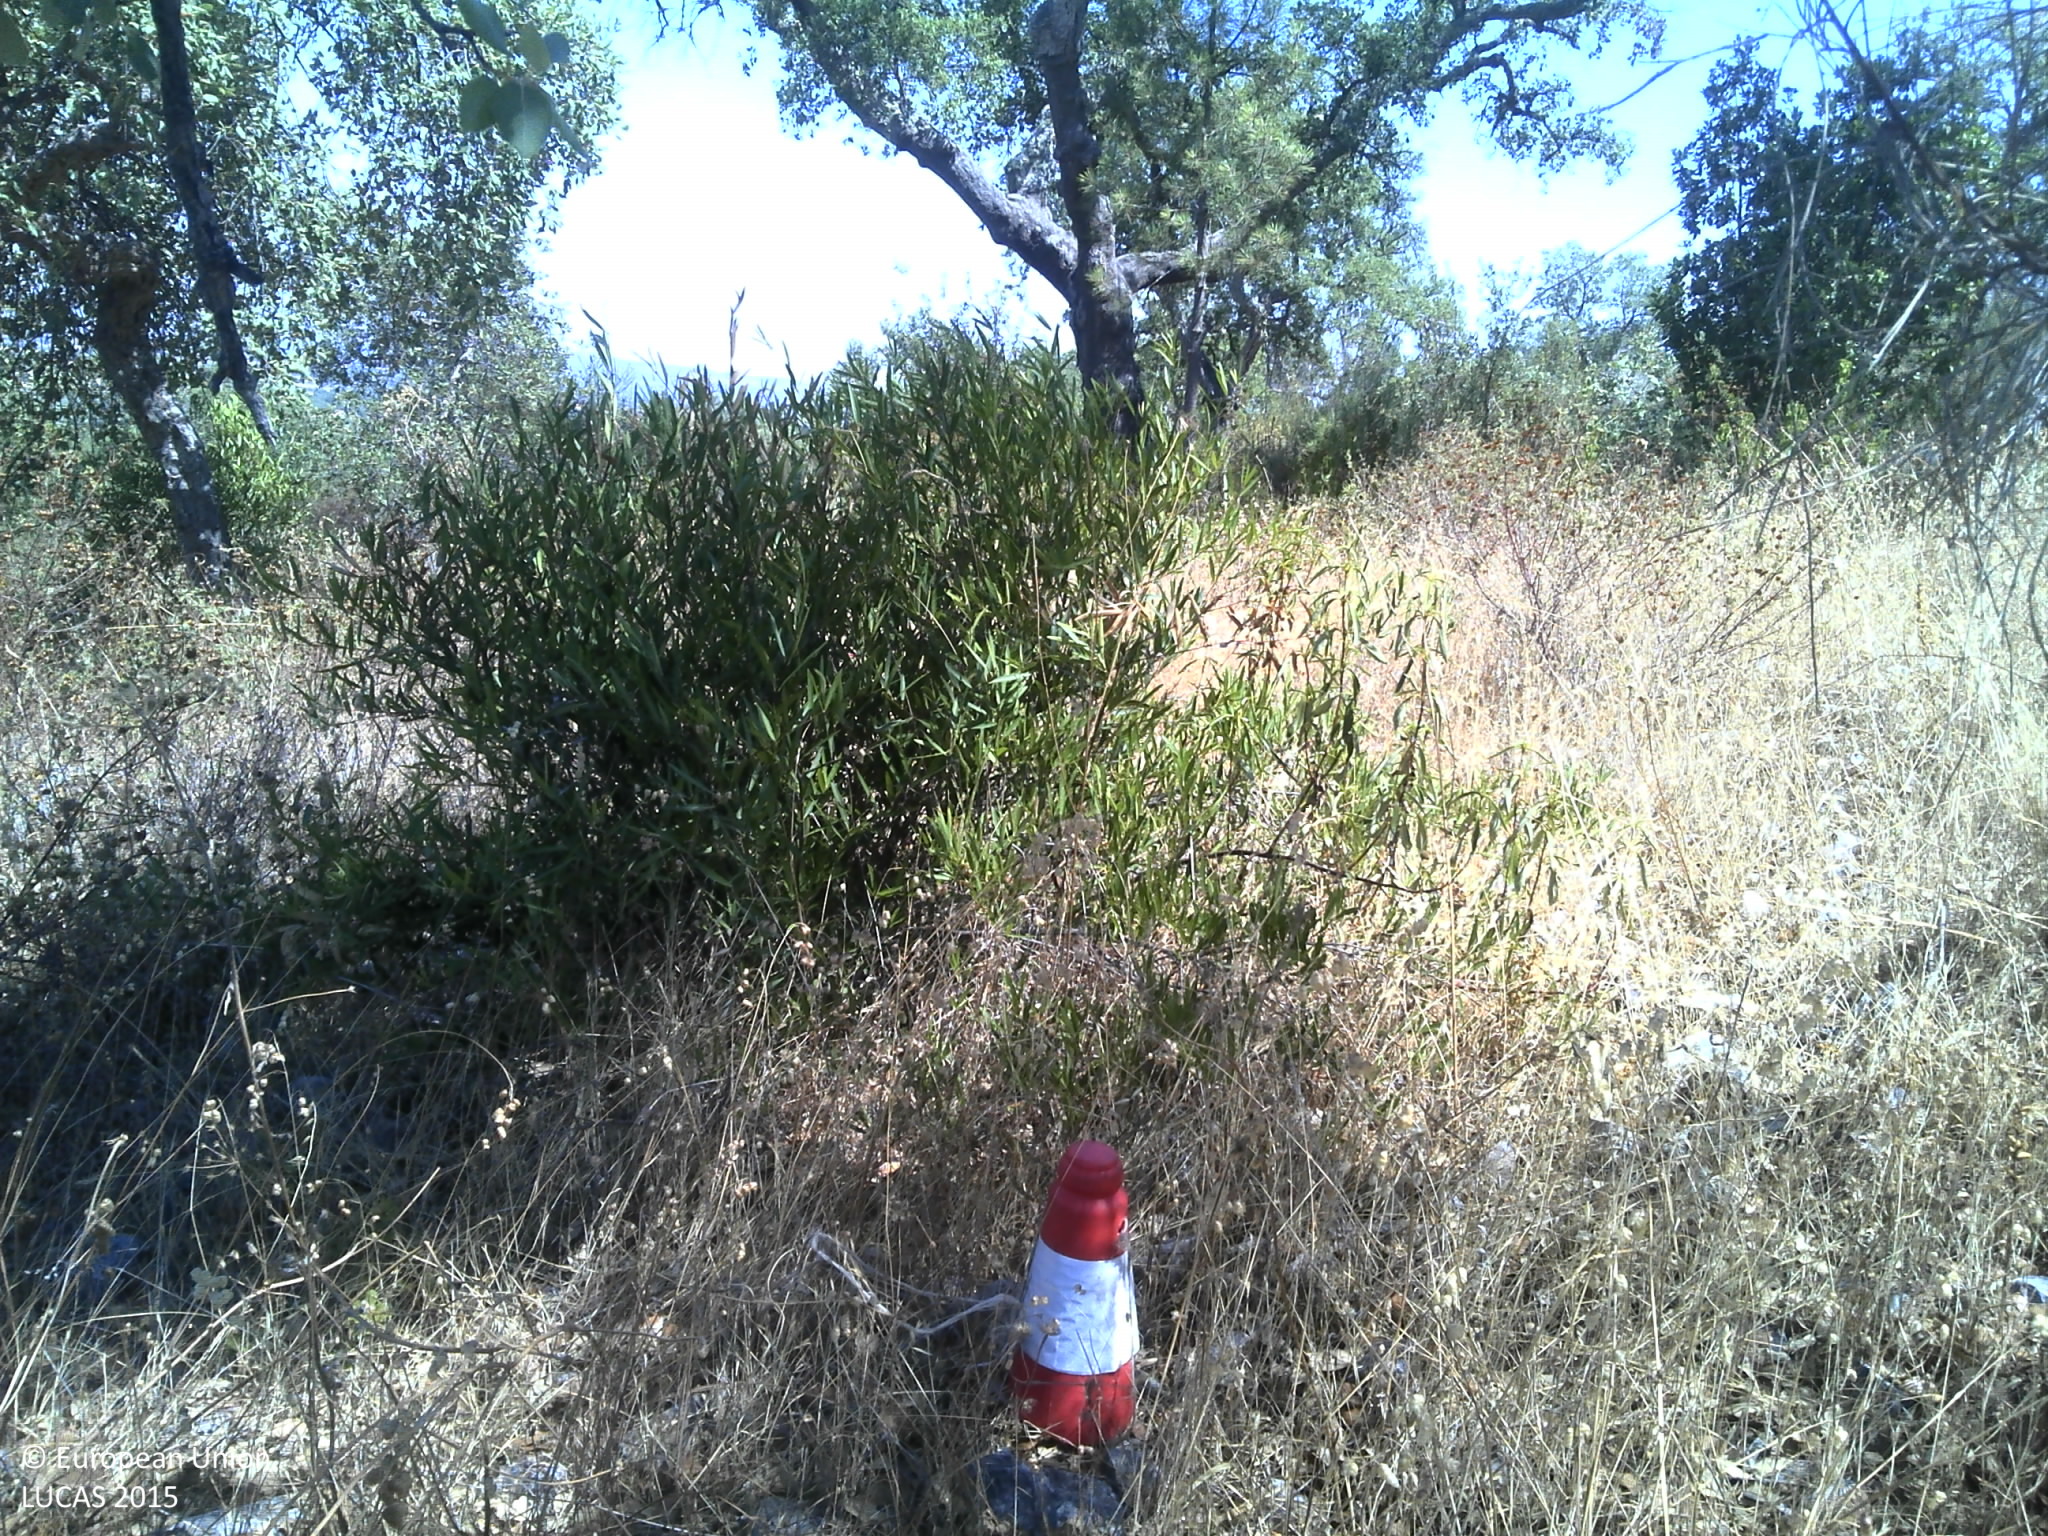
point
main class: Woodland
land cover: Broadleaved woodland
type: broadleaved evergreen forest
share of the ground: 25 - 50 %
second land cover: Grassland without tree/shrub cover
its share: 50 - 75 %
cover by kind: herbaceous plants 50 %, broadleaved forest trees 45 %, shrubs 5 %
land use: Forestry
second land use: Agriculture (excluding fallow land and kitchen gardens)
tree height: > 5 m
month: June
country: PT
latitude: 39.7492
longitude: -7.3075
